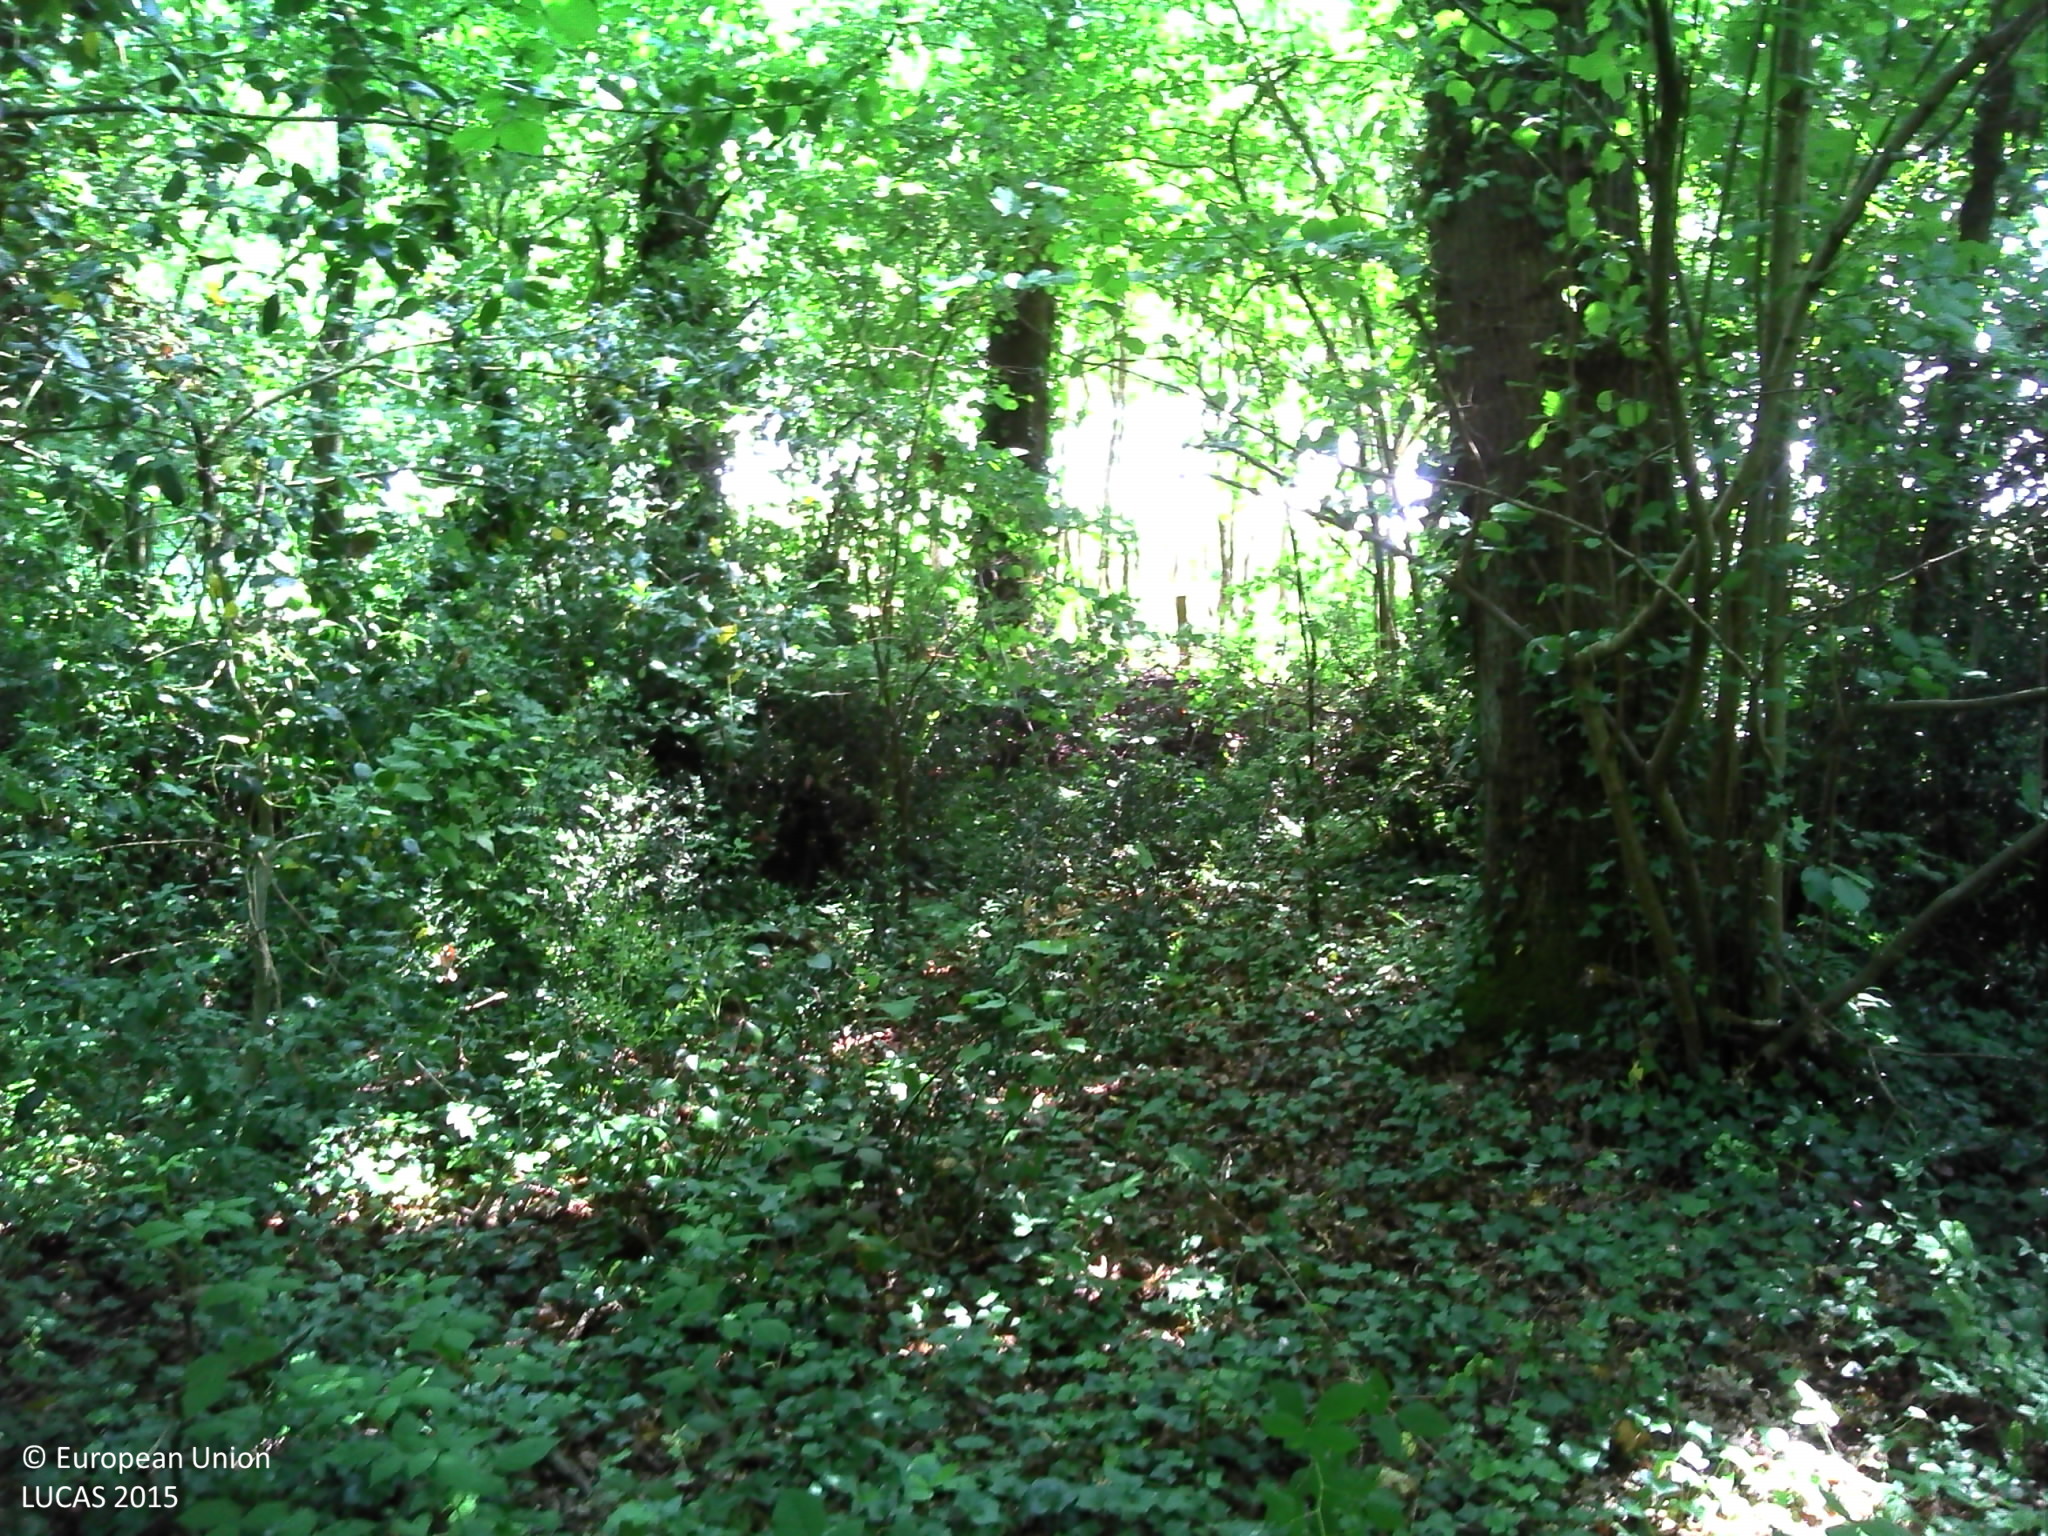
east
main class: Woodland
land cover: Broadleaved woodland
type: mesophytic deciduous forest
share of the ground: > 75 %
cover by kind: broadleaved forest trees 95 %, herbaceous plants 5 %
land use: Semi-natural and natural areas not in use
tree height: > 5 m
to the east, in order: Broadleaved woodland; Fences; Broadleaved woodland; Tracks; Fences; Broadleaved woodland; Apple fruit; Grass margins; Fences; Spontaneously vegetated surfaces; Single bushes/trees; Grass margins; Apple fruit; Grassland without tree/shrub cover; Vineyards
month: June
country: FR
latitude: 47.1701
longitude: -1.4526
